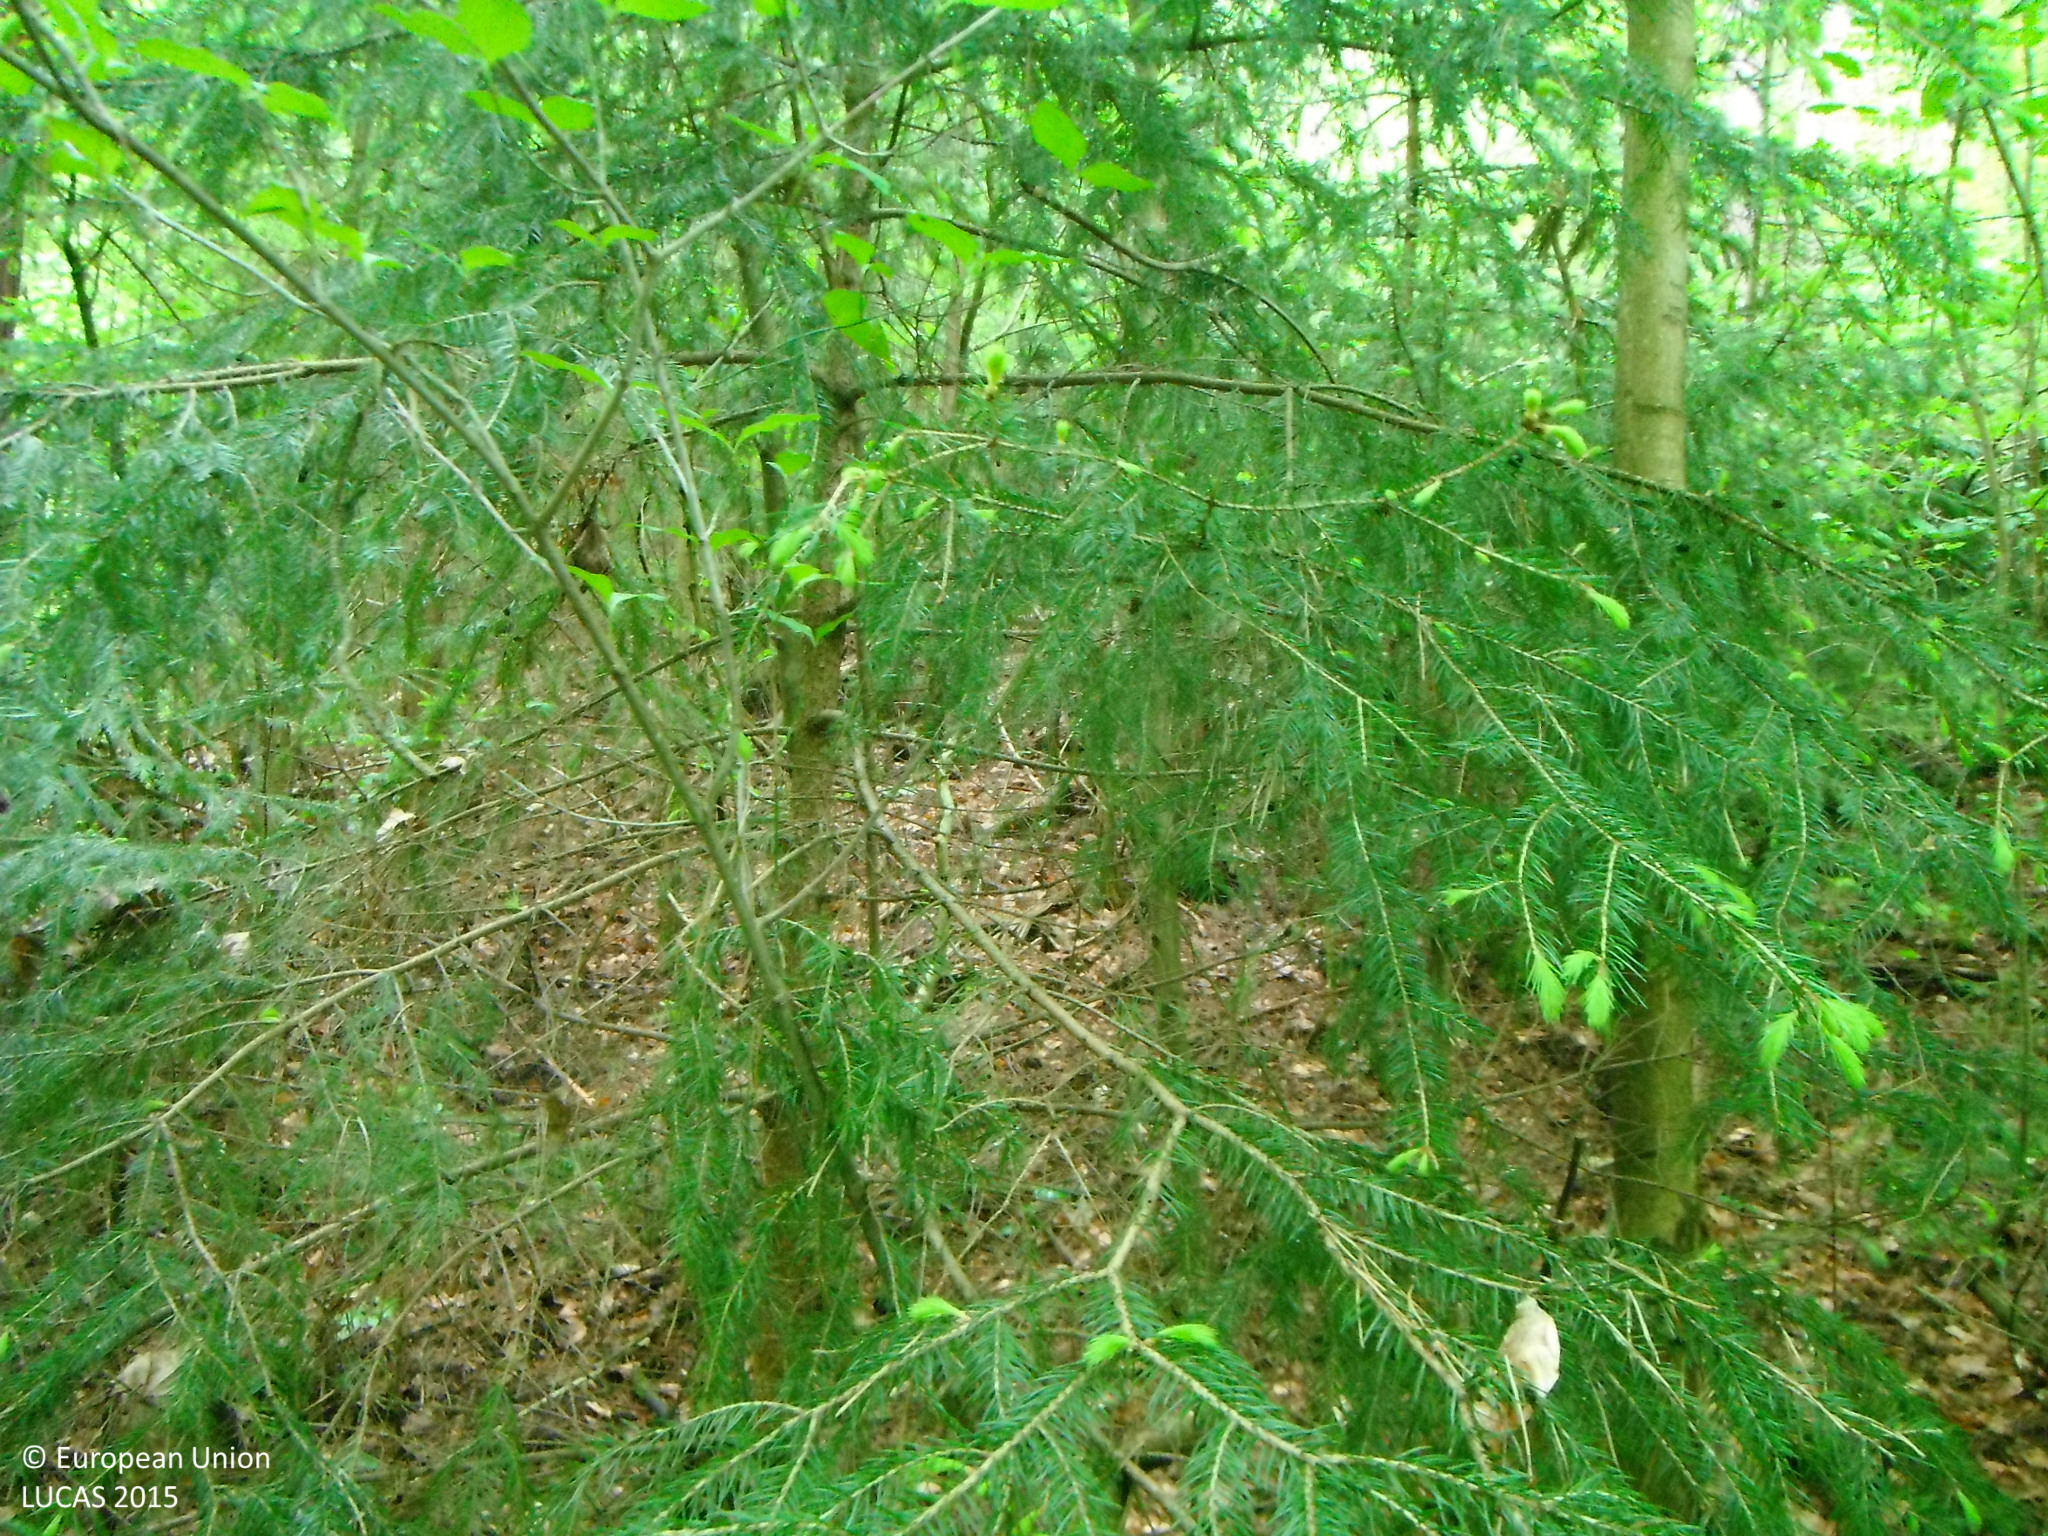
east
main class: Woodland
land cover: Spruce dominated mixed woodland
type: hemiboreal forest and nemoral coniferous forest and mixed broadleaved-coniferous forest
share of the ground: > 75 %
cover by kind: coniferous forest trees 70 %, broadleaved forest trees 30 %
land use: Semi-natural and natural areas not in use
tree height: > 5 m
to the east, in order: Spruce dominated mixed woodland; Pine dominated mixed woodland; Tracks; Pine dominated mixed woodland
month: May
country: SK
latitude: 48.7657
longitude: 19.1514
